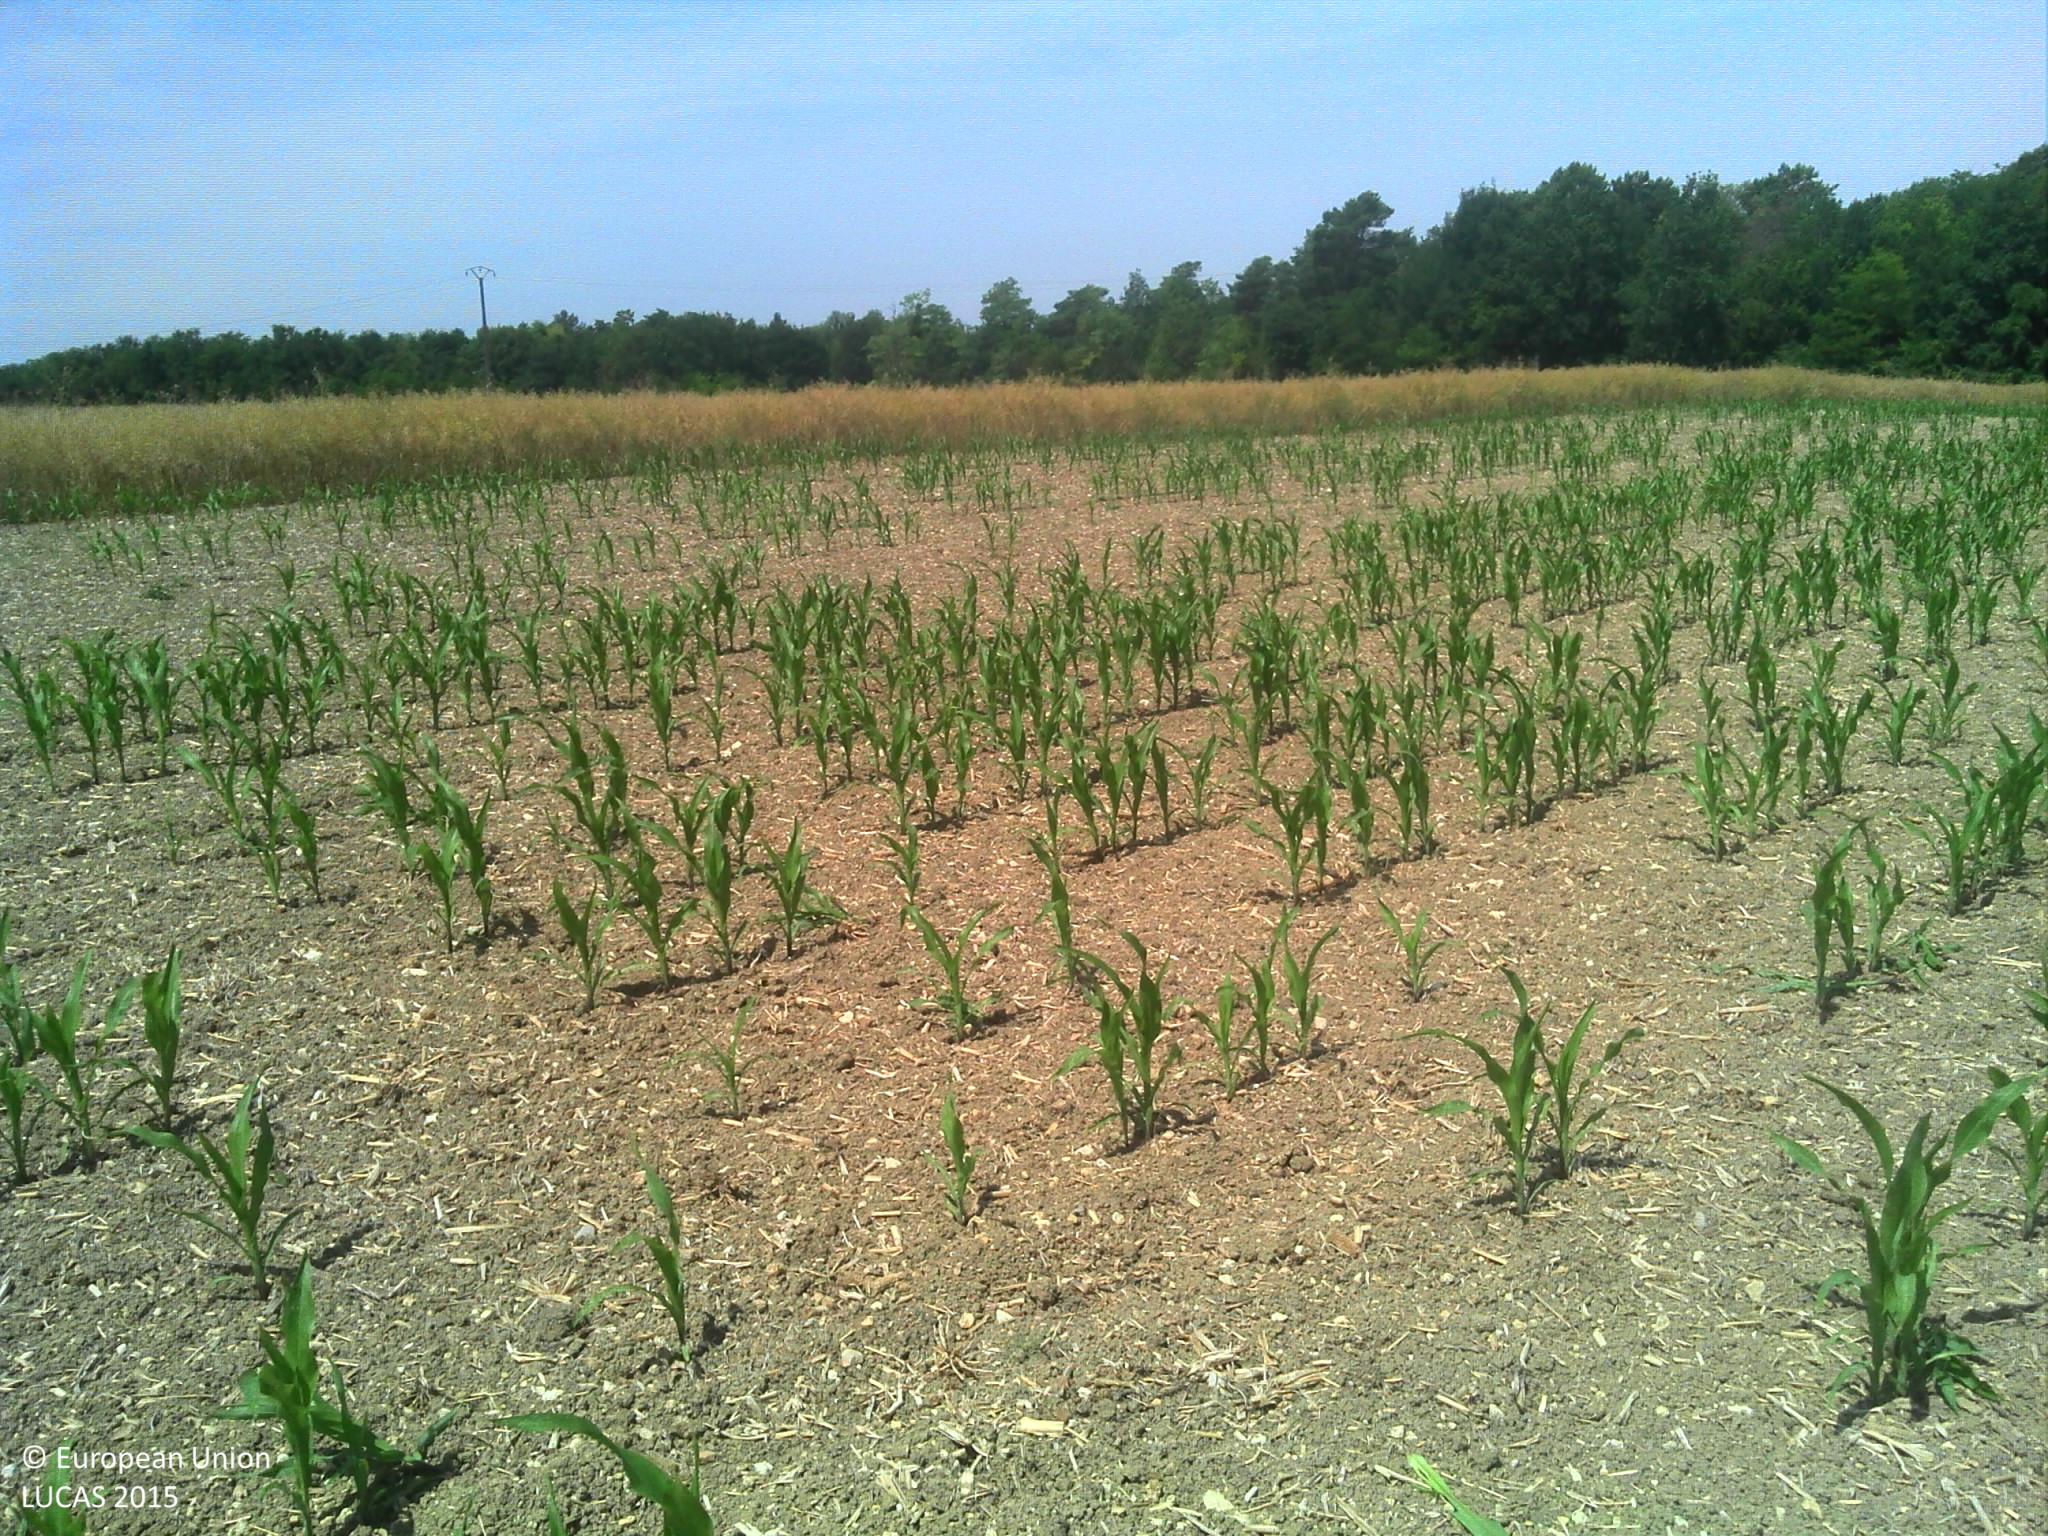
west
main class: Cropland
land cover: Maize
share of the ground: 10 - 25 %
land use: Agriculture (excluding fallow land and kitchen gardens)
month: June
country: FR
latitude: 47.4866
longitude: 1.3719
